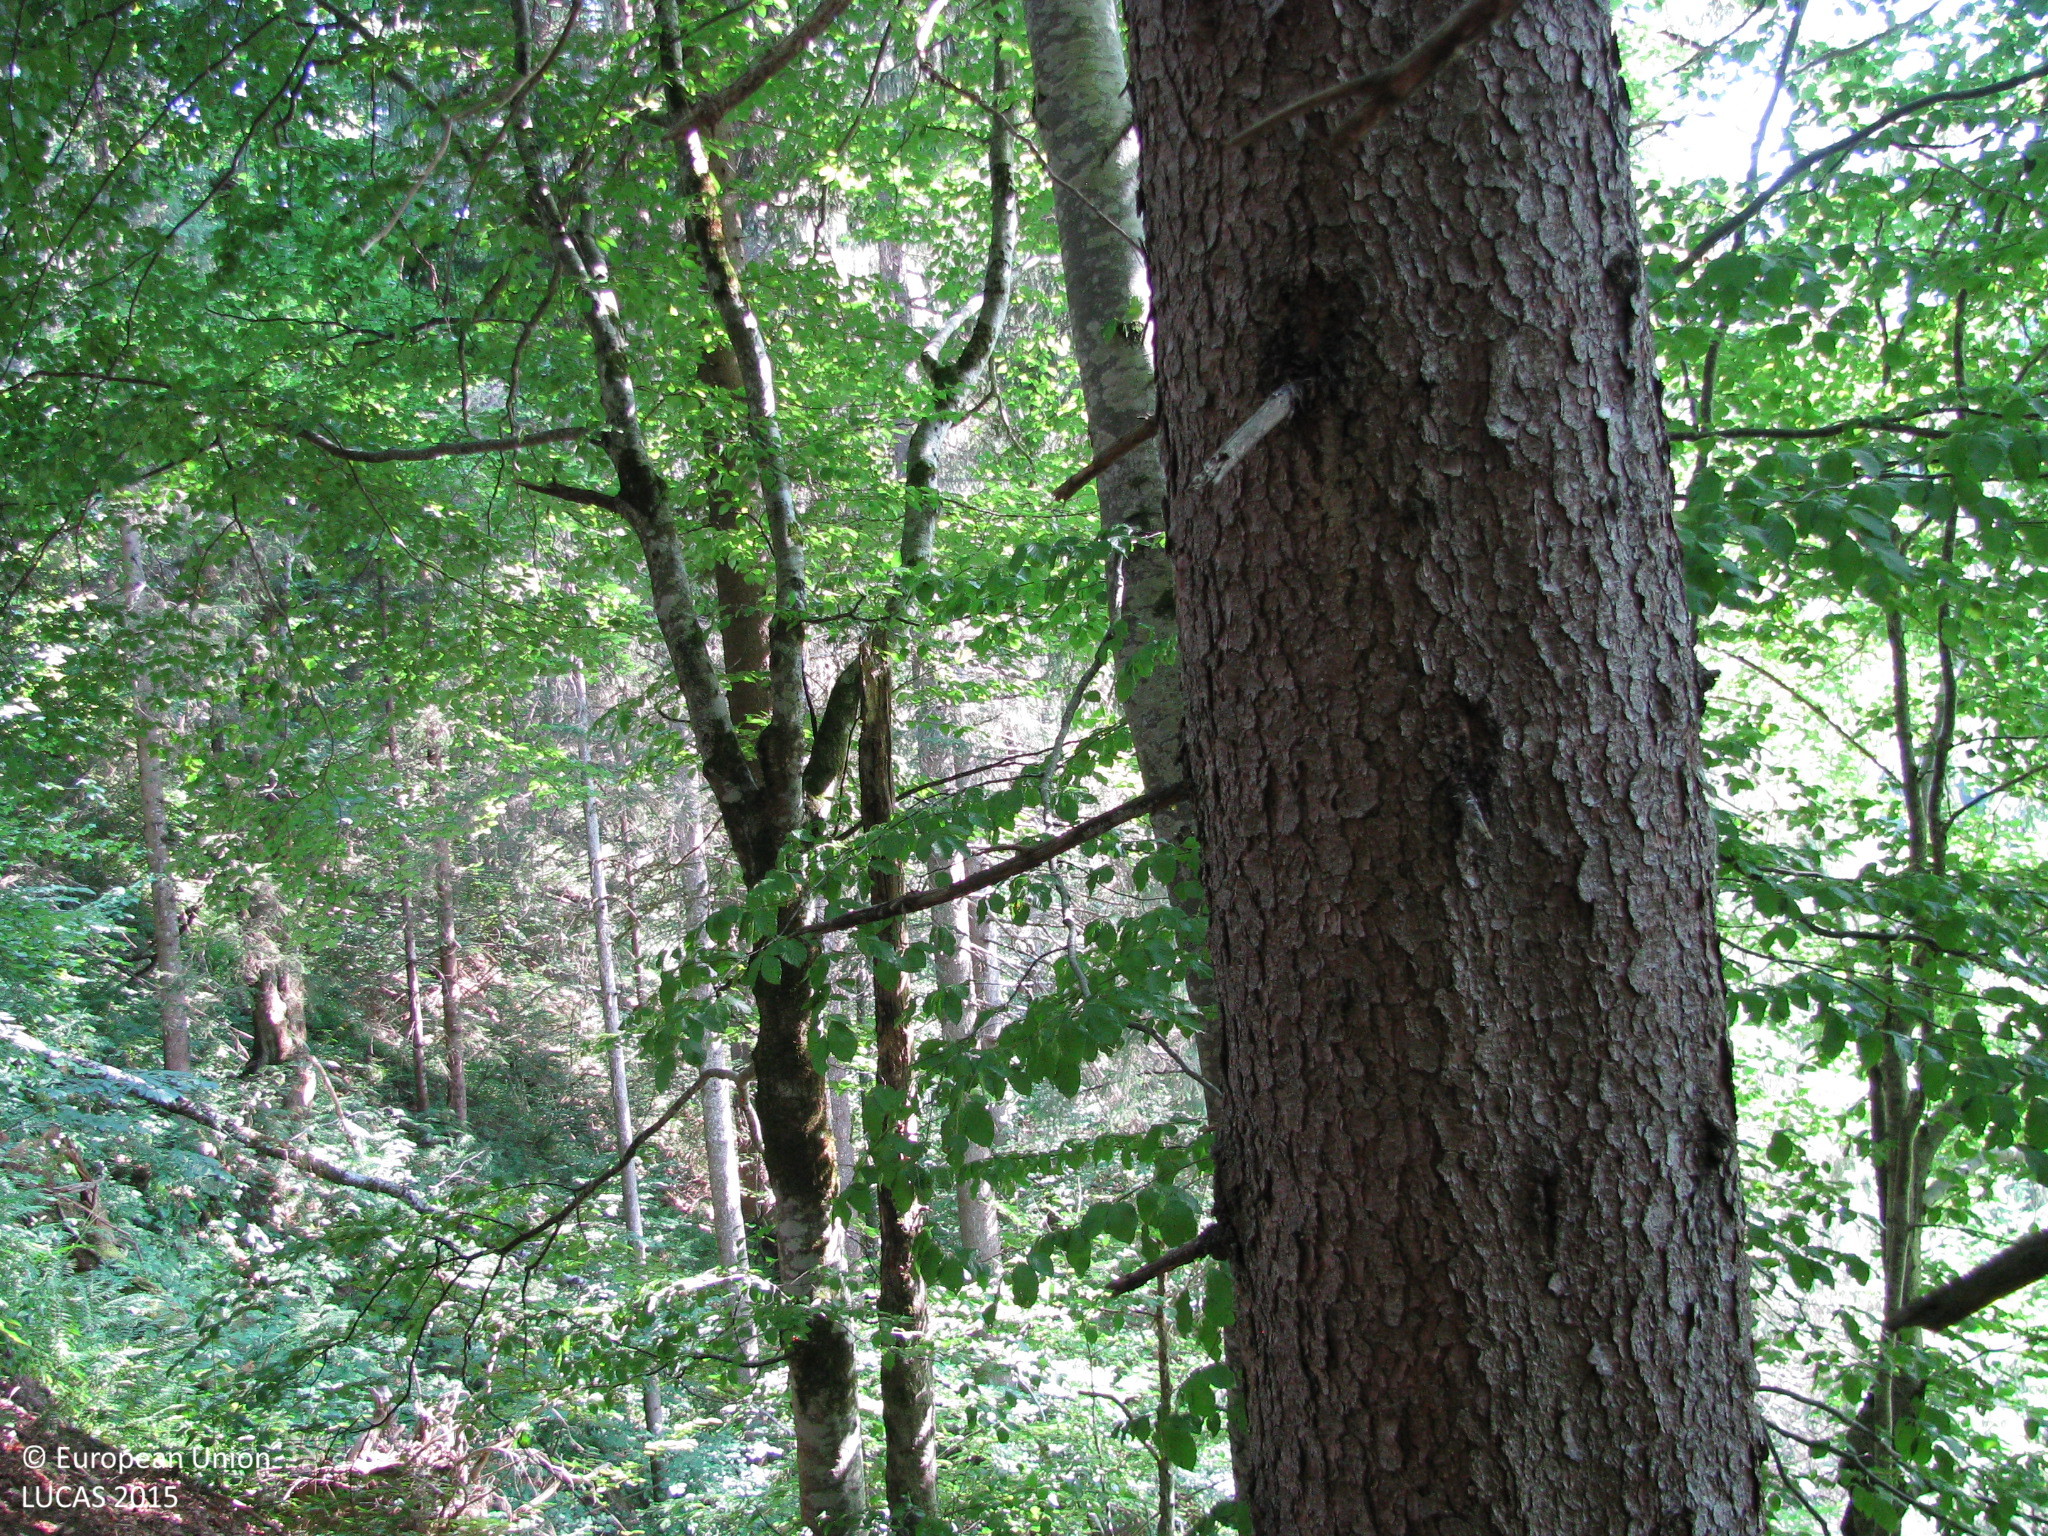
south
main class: Woodland
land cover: Spruce dominated mixed woodland
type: alpine coniferous forest
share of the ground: > 75 %
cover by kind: coniferous forest trees 50 %, broadleaved forest trees 35 %, unconsolidated bare surface 10 %, herbaceous plants 5 %
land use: Forestry
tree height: > 5 m
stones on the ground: < 10 %
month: July
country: AT
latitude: 46.6928
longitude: 12.8088
